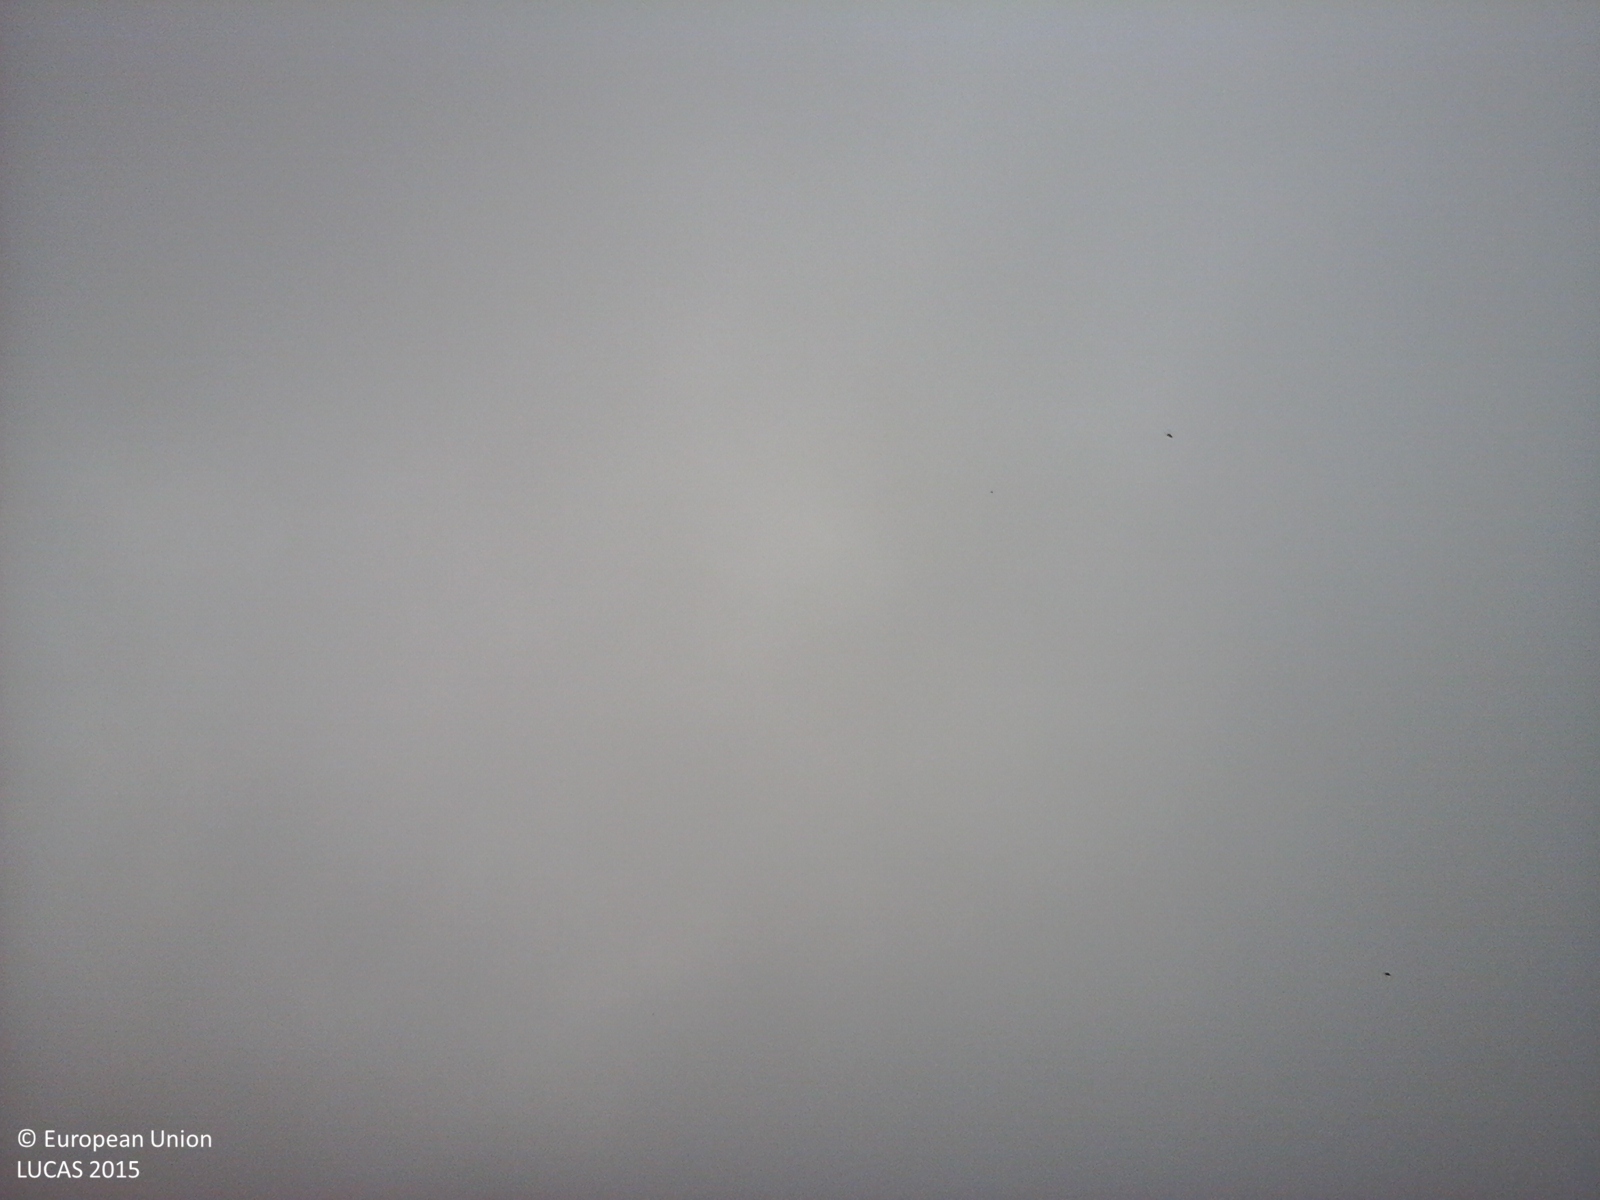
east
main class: Grassland
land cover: Grassland without tree/shrub cover
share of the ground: > 75 %
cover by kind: herbaceous plants 100 %
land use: Agriculture (excluding fallow land and kitchen gardens)
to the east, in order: Grassland without tree/shrub cover
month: July
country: IT
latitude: 44.4732
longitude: 7.1269
